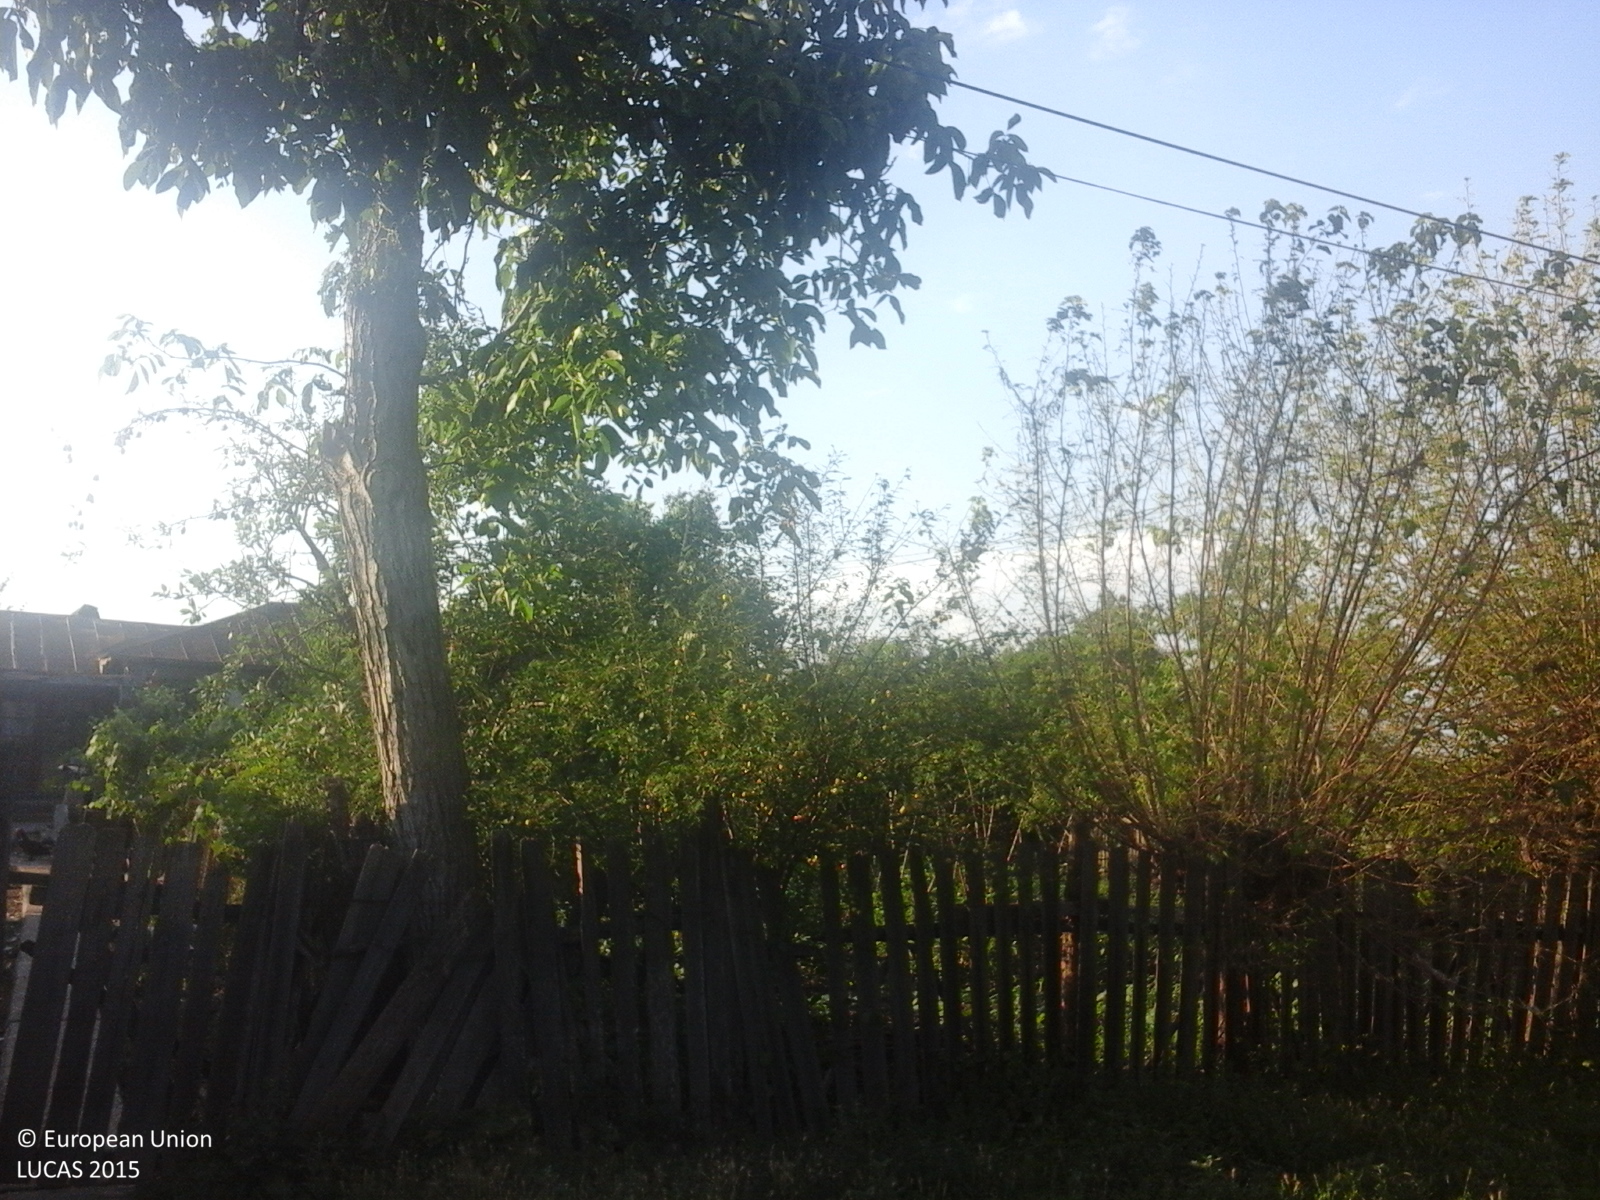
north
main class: Cropland
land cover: Other fresh vegetables
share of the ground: > 75 %
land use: Kitchen garden
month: July
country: RO
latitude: 43.9541
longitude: 25.9344
